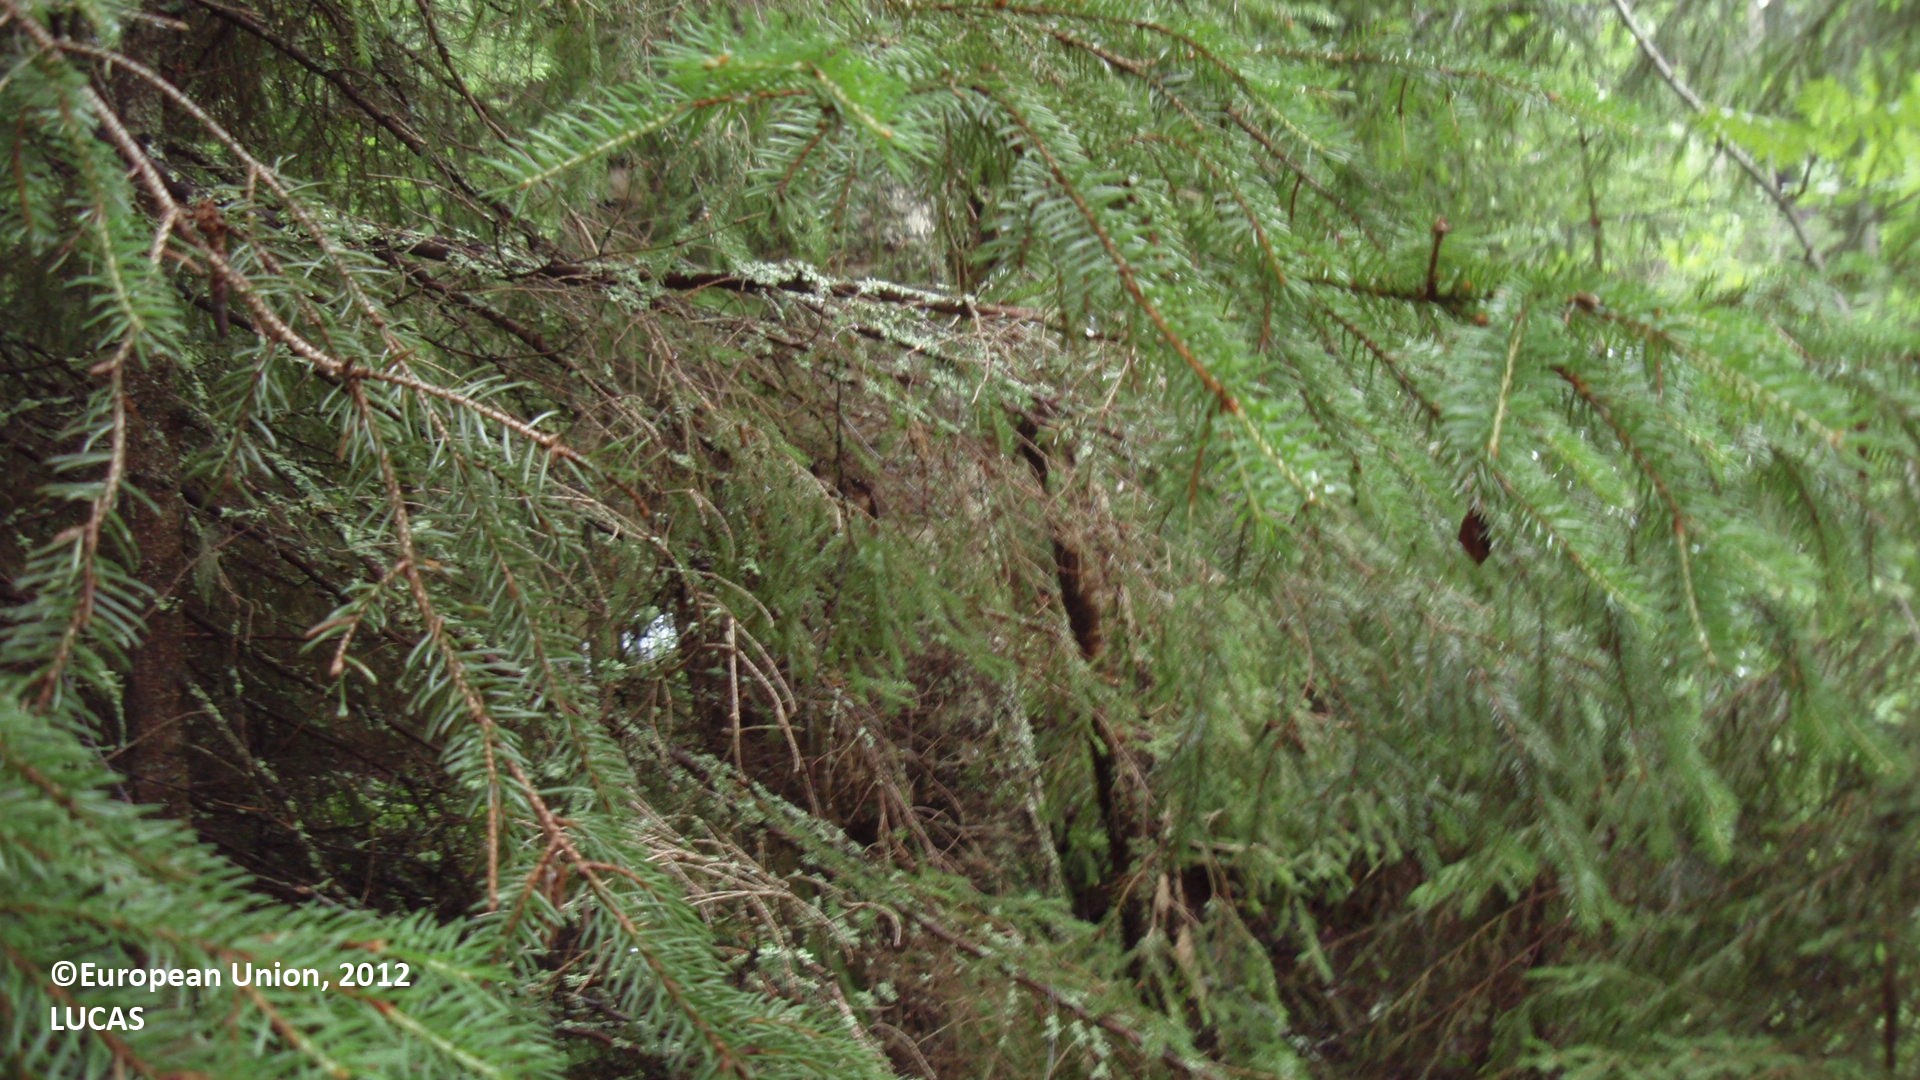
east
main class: Woodland
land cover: Pine dominated mixed woodland
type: boreal forest
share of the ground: 50 - 75 %
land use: Forestry
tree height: > 5 m
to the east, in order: Pine dominated mixed woodland; Grassland with sparse tree/shrub cover; Broadleaved woodland; Grassland with sparse tree/shrub cover; Artificial constructions in urban areas; Grass margins; Paved roads, cycling and walking lanes; Grass margins; Shrubland without tree cover; Broadleaved woodland; Spruce dominated coniferous woodland; Ditches and canals; Spruce dominated coniferous woodland
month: July
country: FI
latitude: 61.5545
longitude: 26.8888
